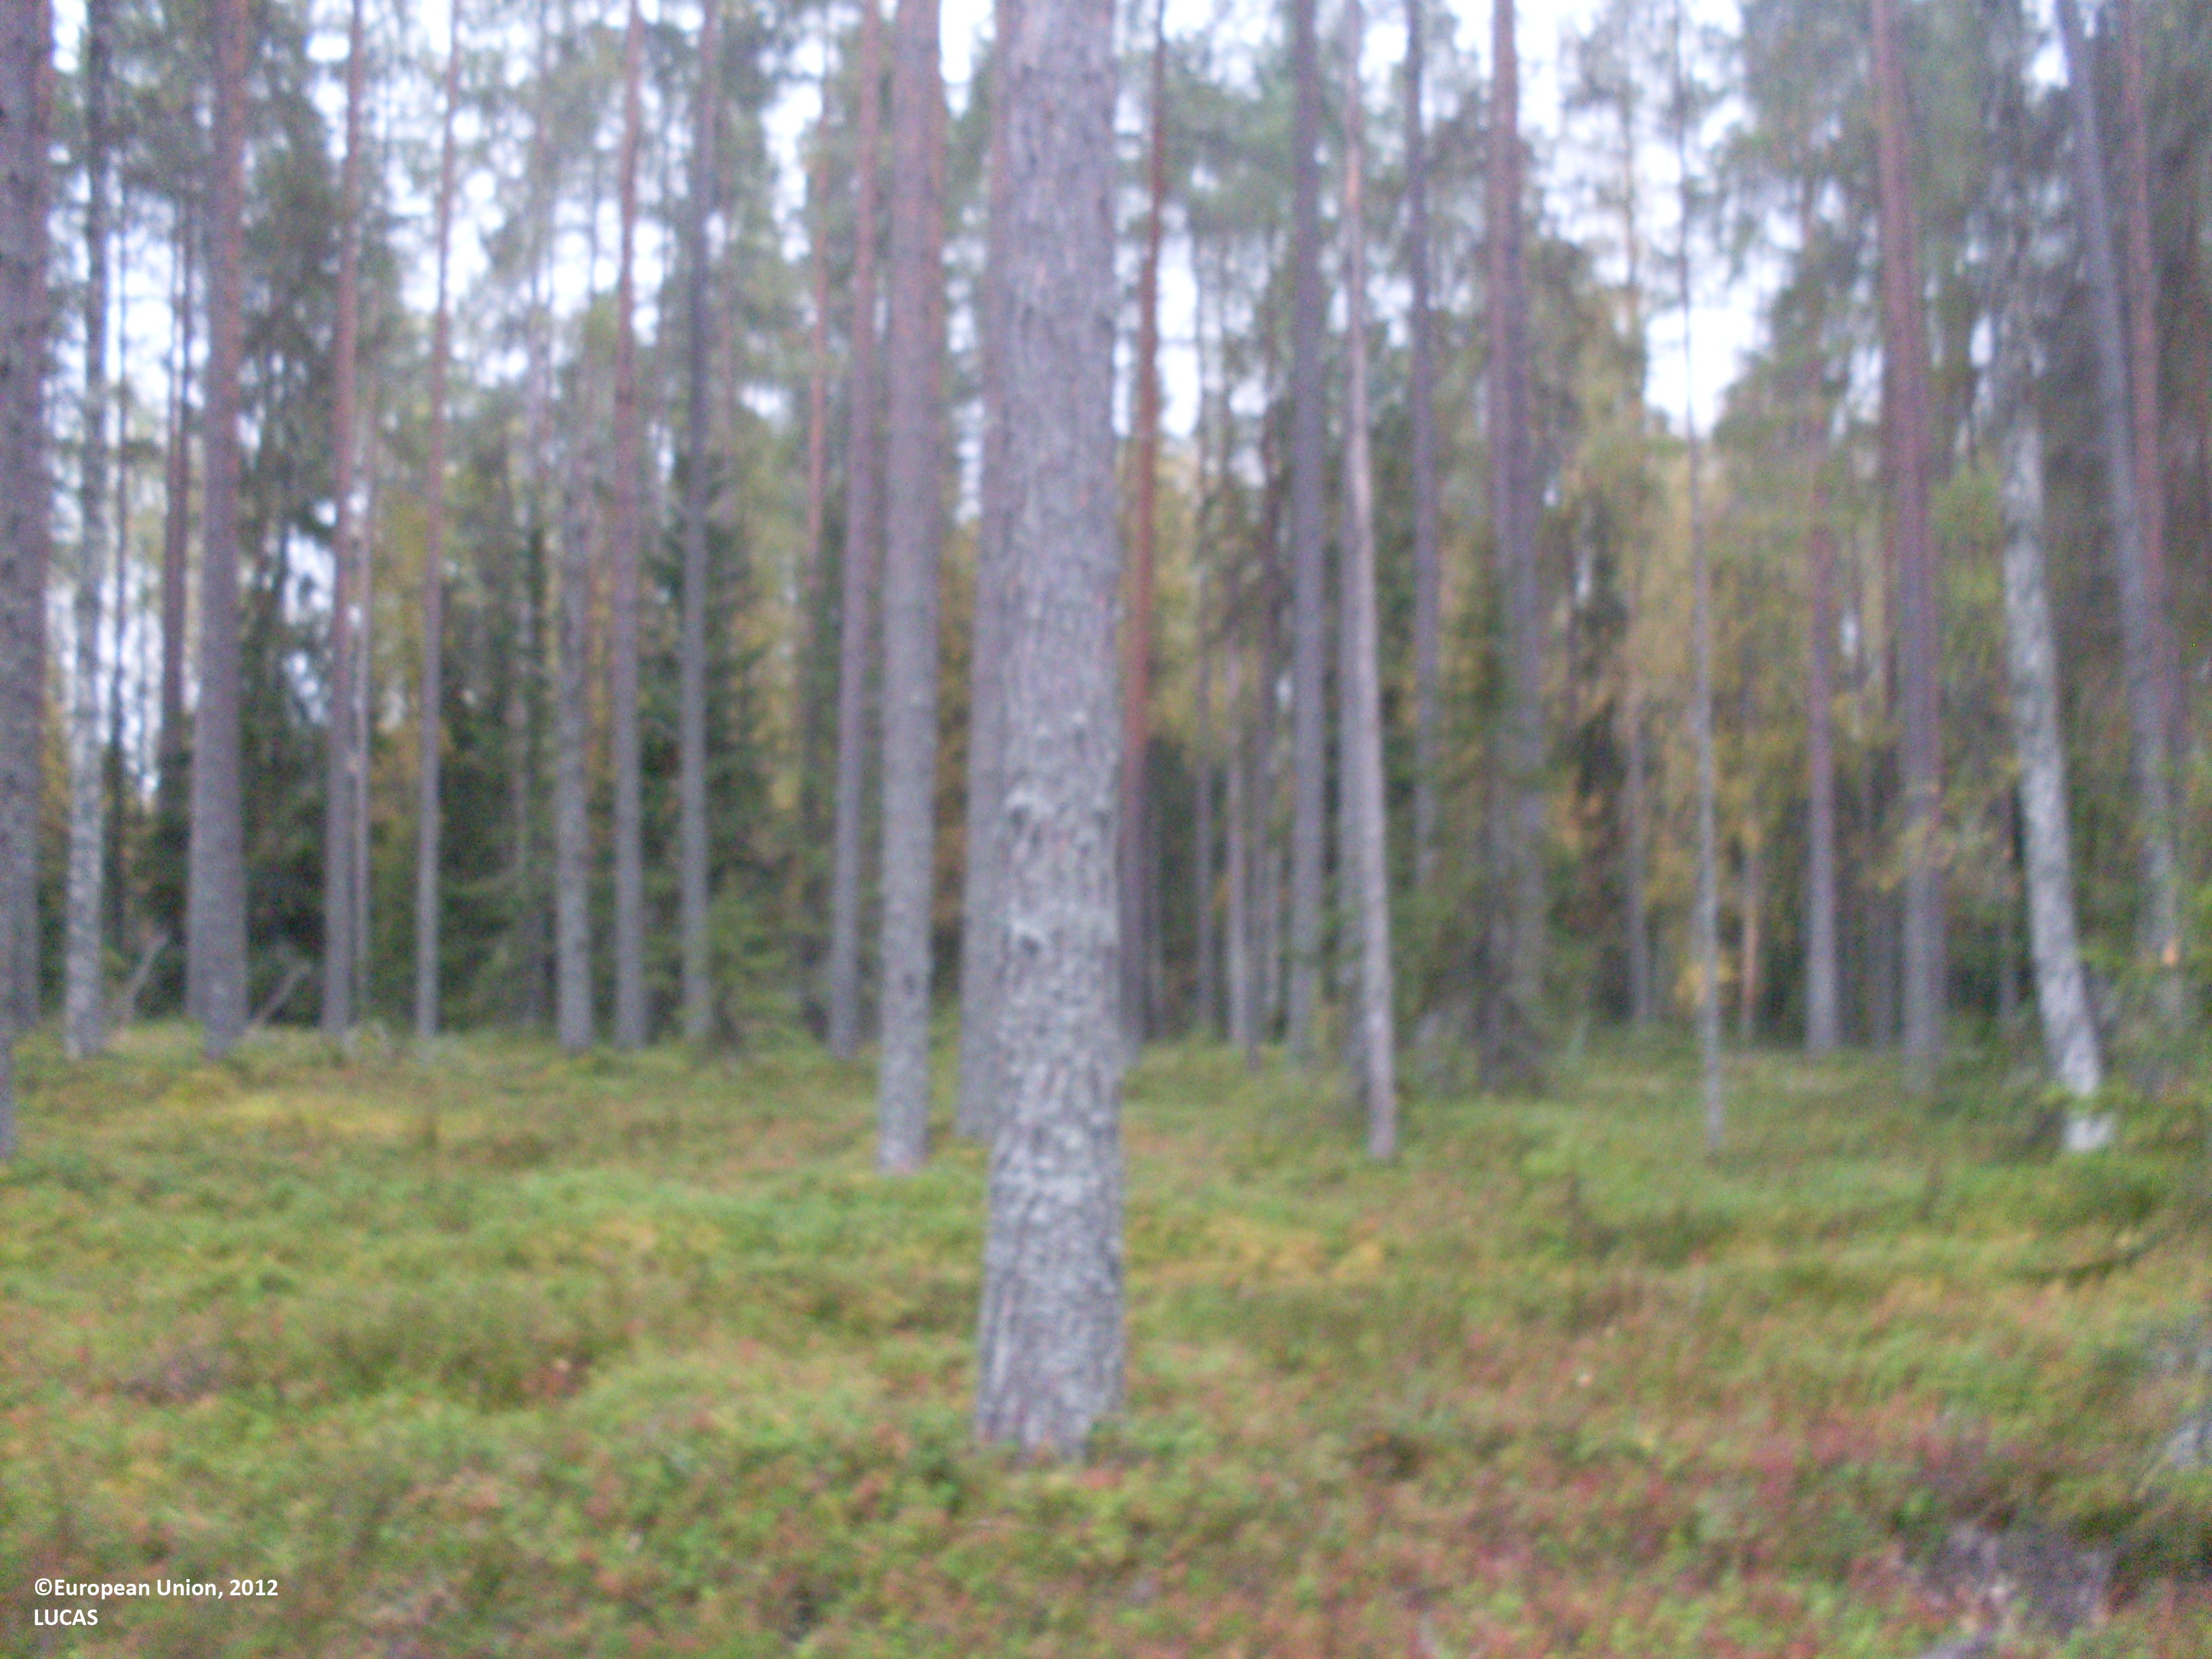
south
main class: Woodland
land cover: Pine dominated coniferous woodland
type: boreal forest
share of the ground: 25 - 50 %
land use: Forestry
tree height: > 5 m
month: September
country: FI
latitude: 64.1698
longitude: 28.9790
